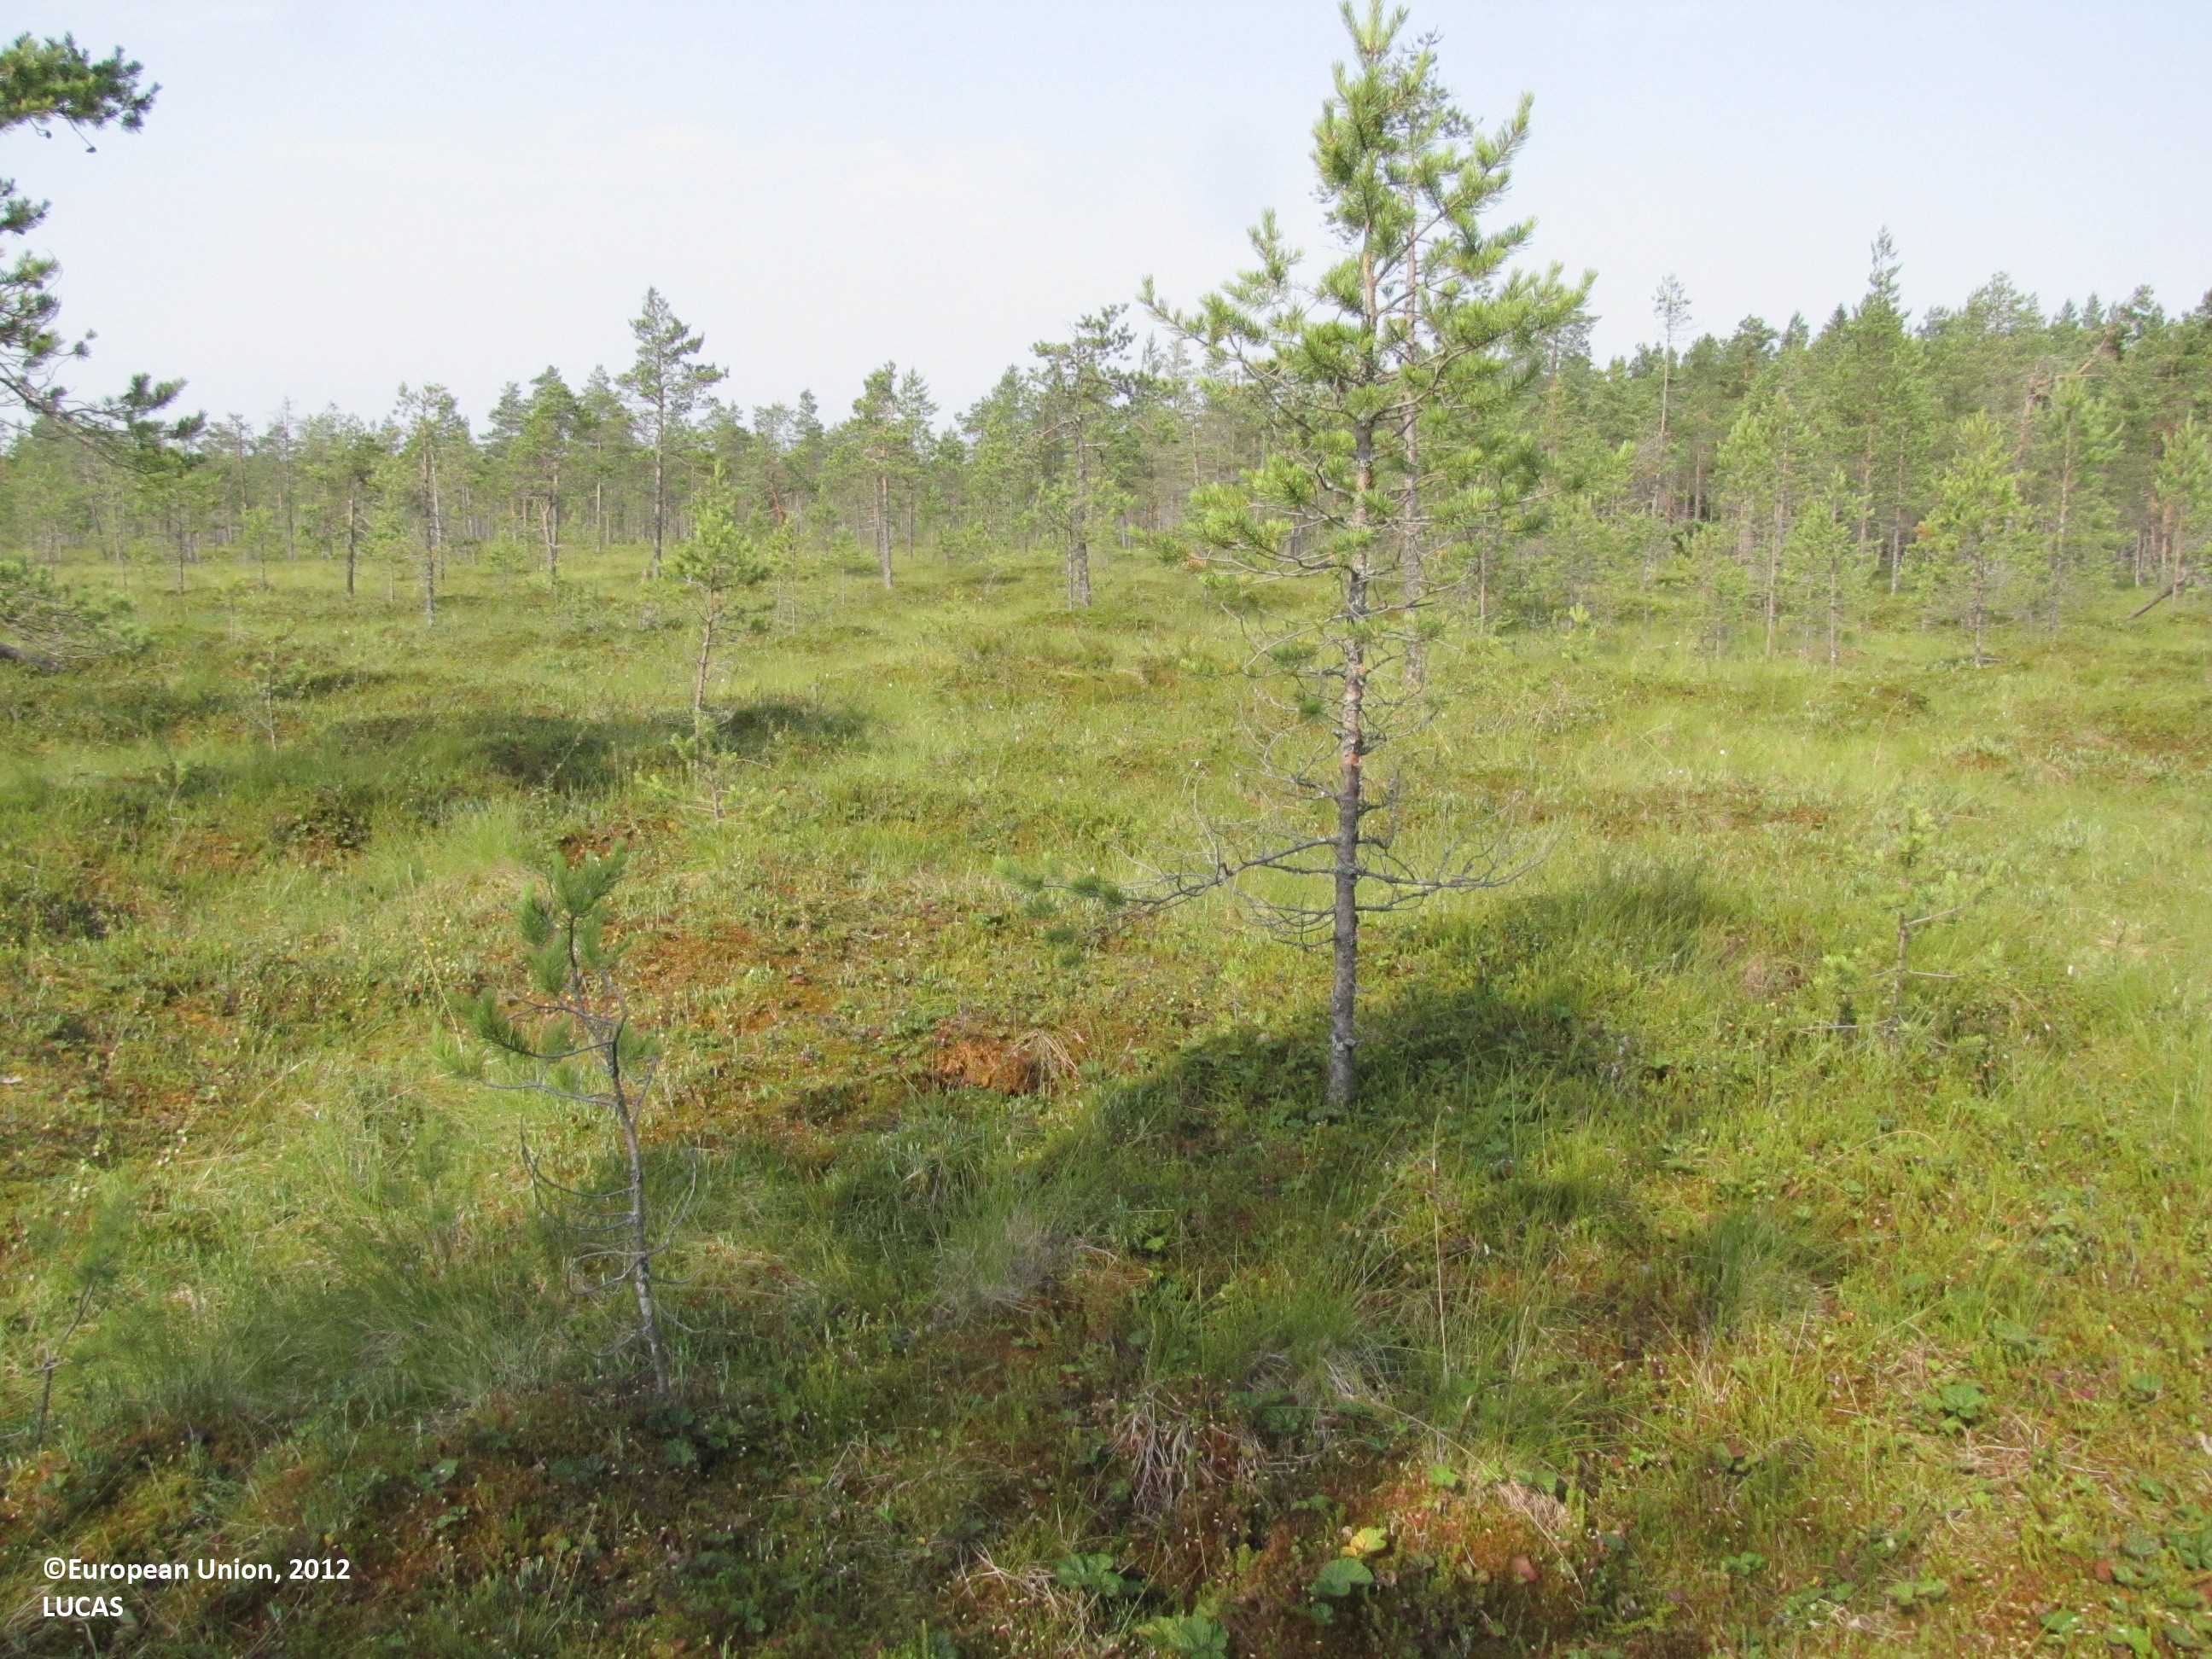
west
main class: Woodland
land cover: Pine dominated coniferous woodland
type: mire and swamp forests
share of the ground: 25 - 50 %
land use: Community services
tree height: < 5 m
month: July
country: FI
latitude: 62.0566
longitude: 23.2896
